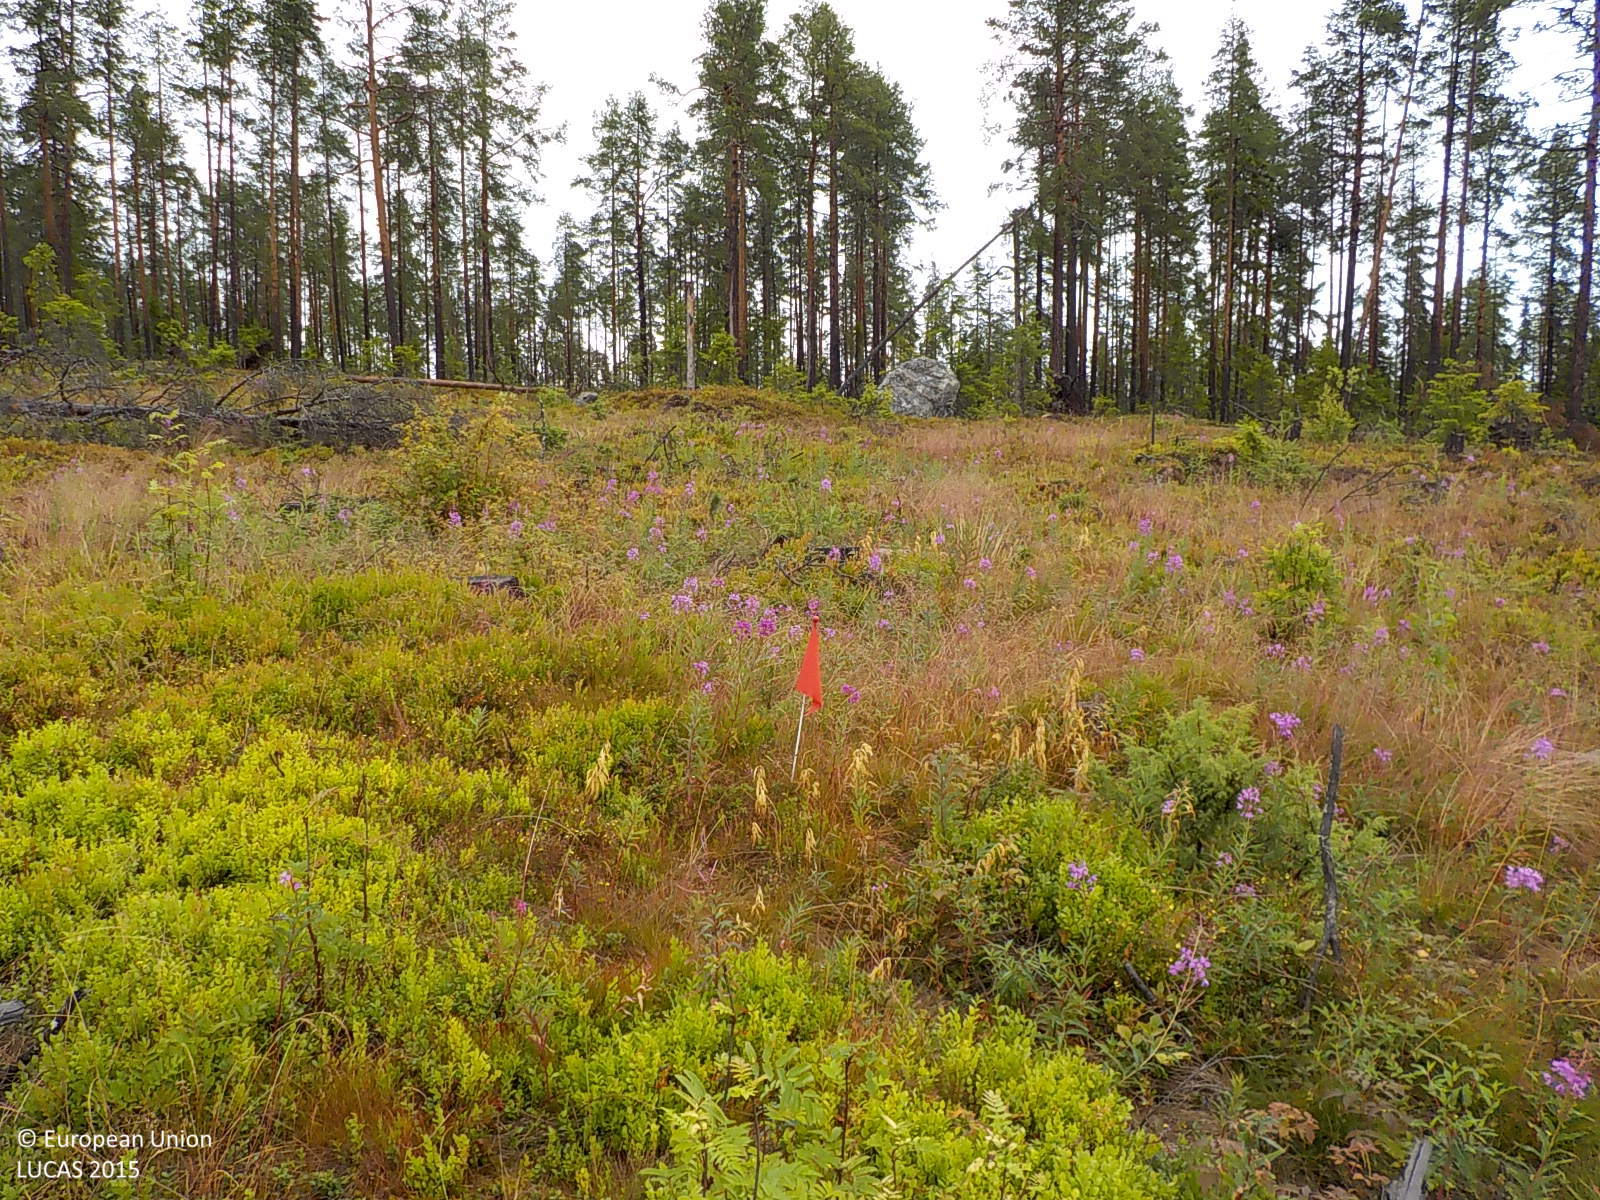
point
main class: Woodland
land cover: Other mixed woodland
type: boreal forest
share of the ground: 50 - 75 %
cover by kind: shrubs 45 %, broadleaved forest trees 30 %, coniferous forest trees 25 %
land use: Forestry
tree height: < 5 m
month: July
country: SE
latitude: 63.1765
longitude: 16.9477
